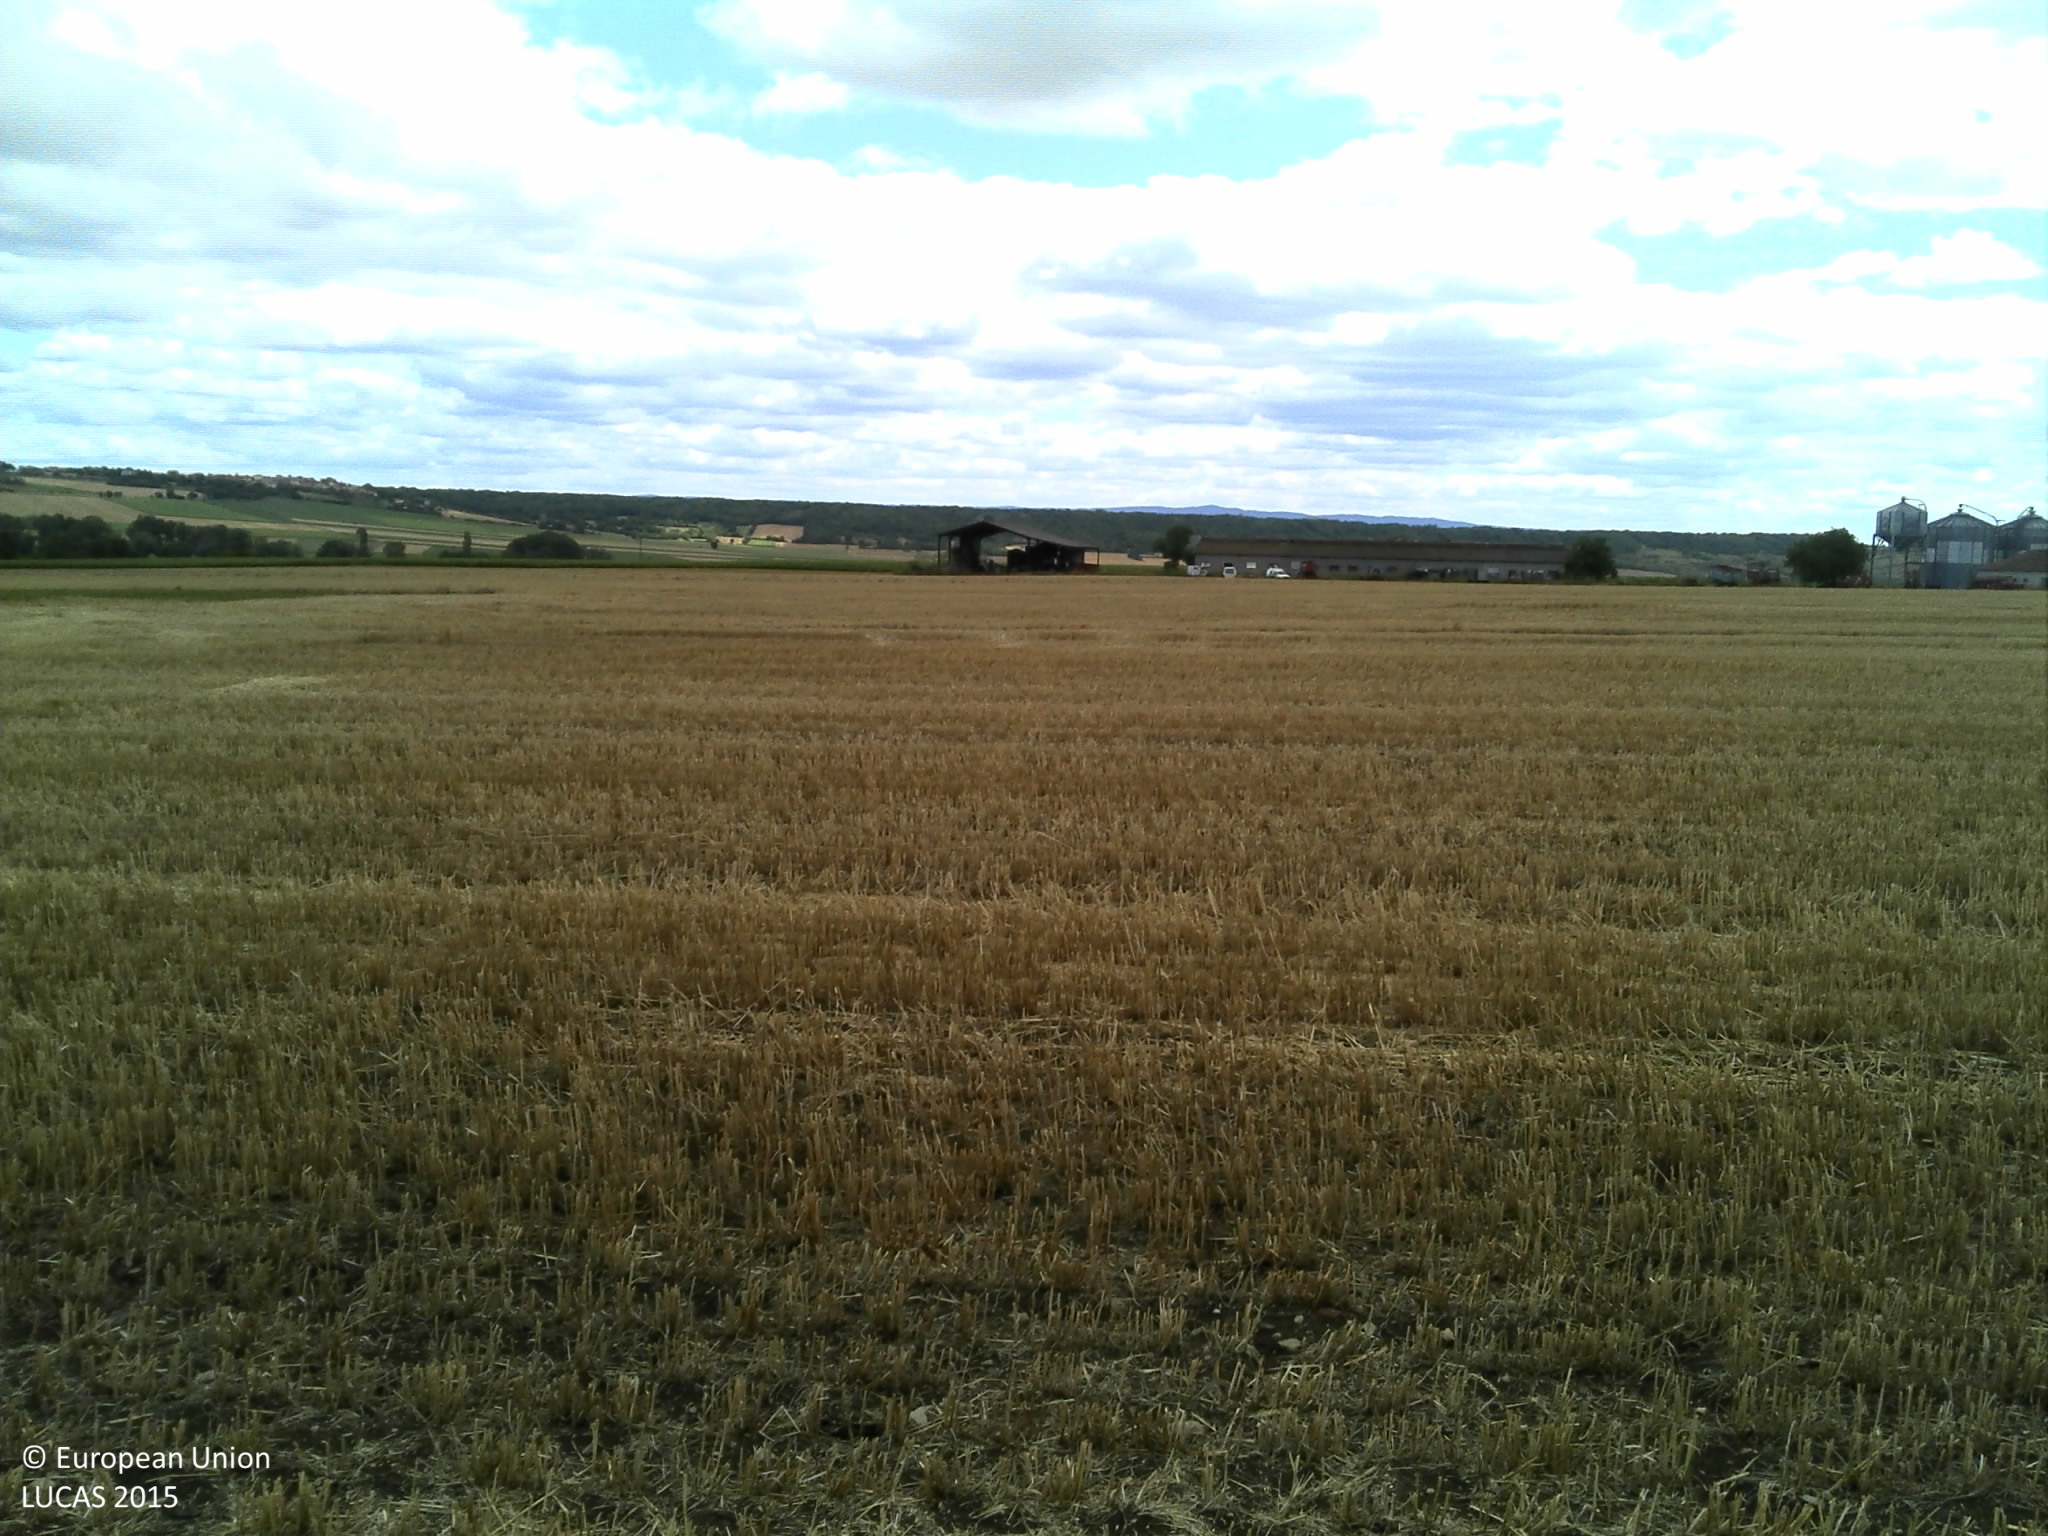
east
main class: Cropland
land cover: Potatoes
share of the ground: < 10 %
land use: Kitchen garden
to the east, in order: Potatoes; Common wheat; Other bare soil; Common wheat
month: July
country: FR
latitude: 45.5007
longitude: 3.1797
